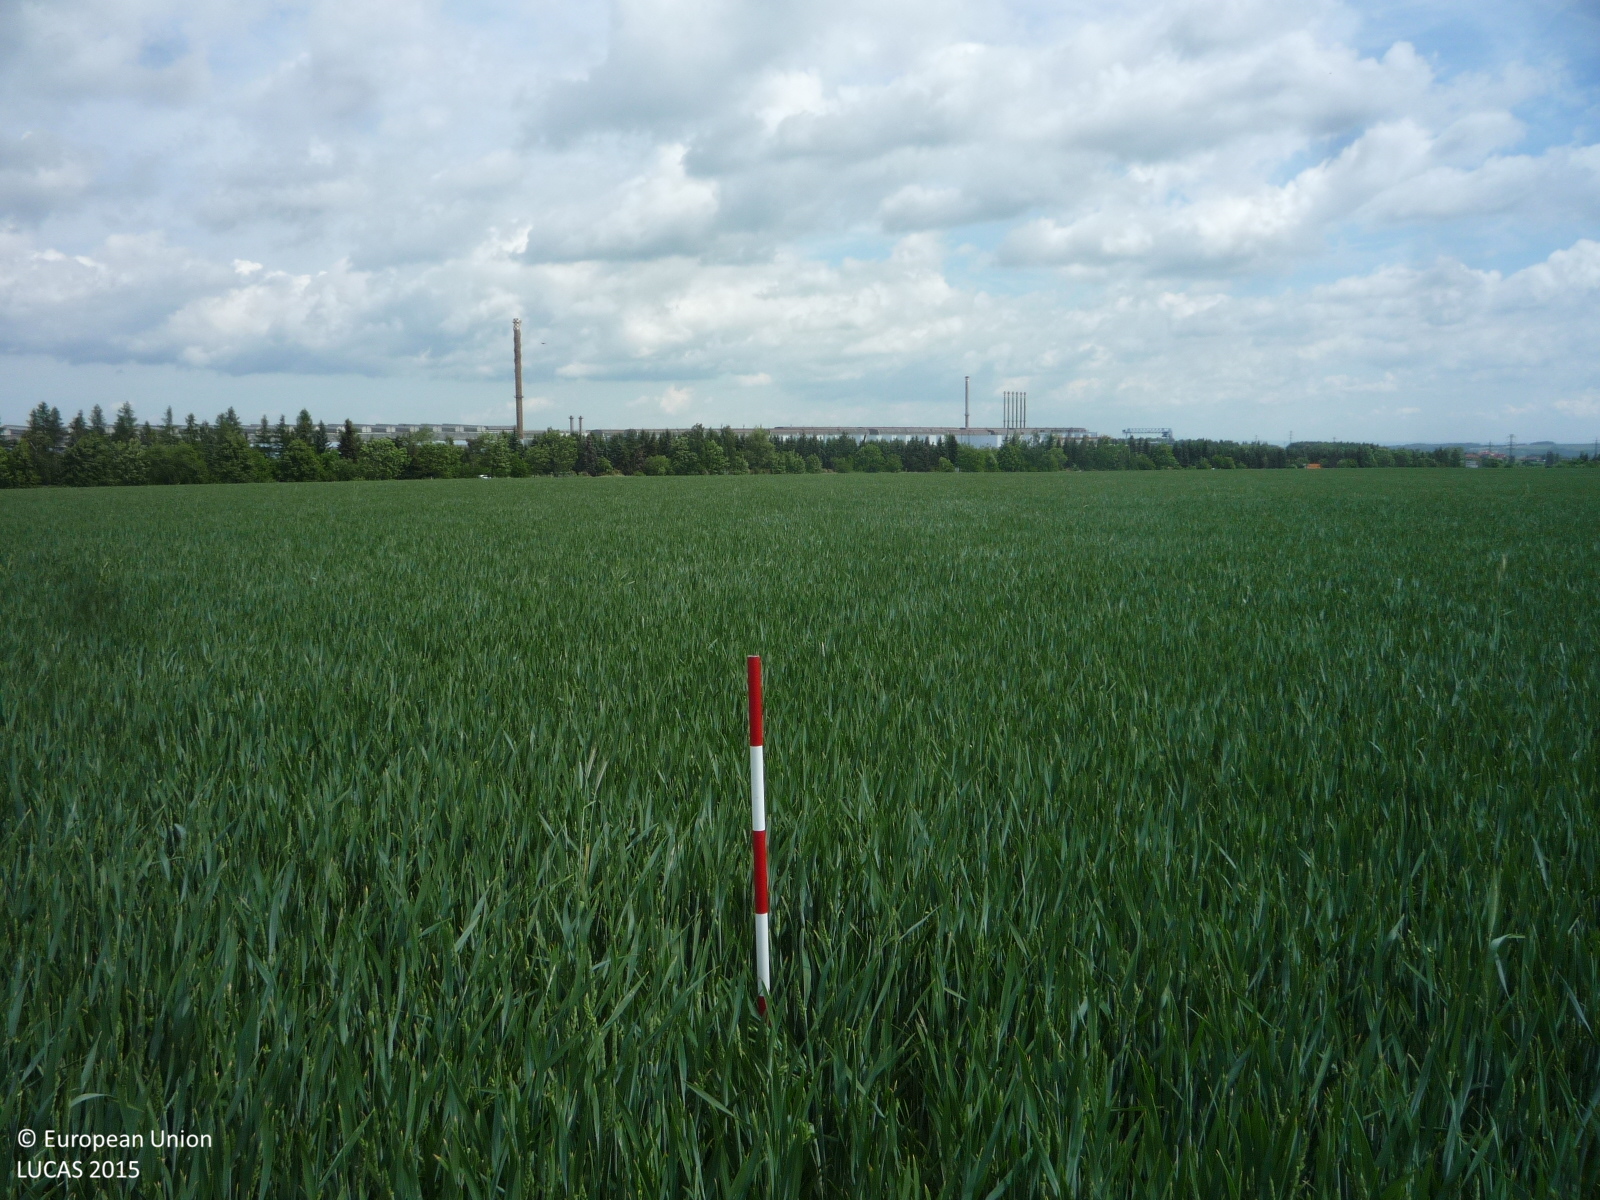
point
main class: Cropland
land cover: Common wheat
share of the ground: > 75 %
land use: Agriculture (excluding fallow land and kitchen gardens)
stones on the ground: < 10 %
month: June
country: CZ
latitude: 50.1445
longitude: 14.1571
